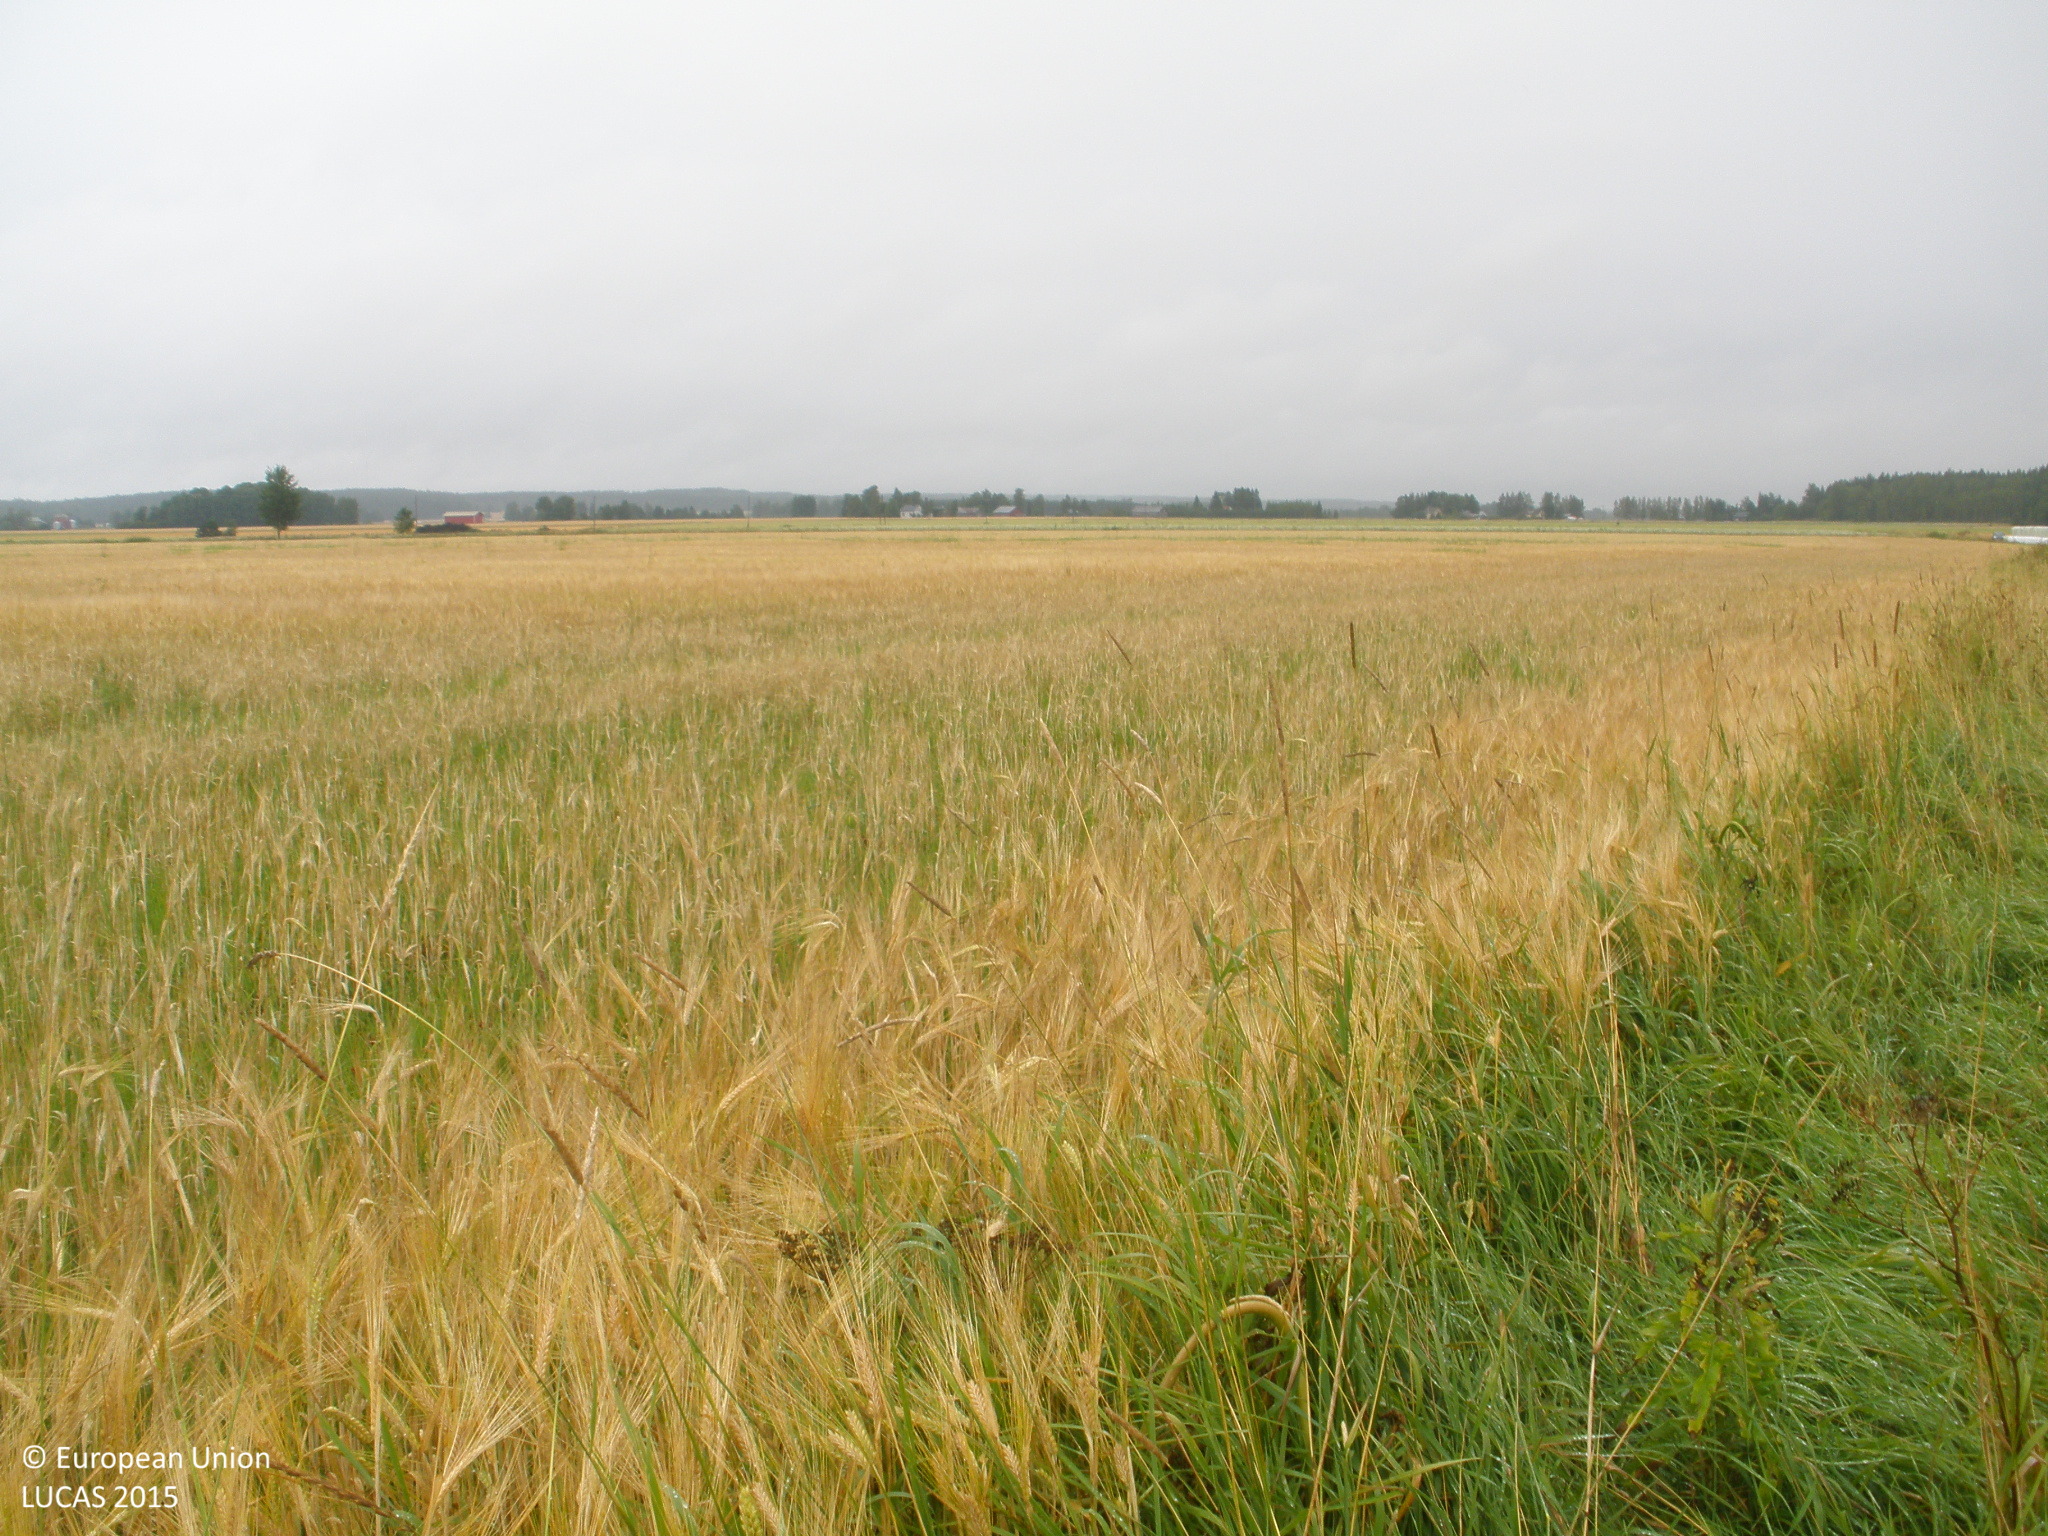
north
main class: Cropland
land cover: Barley
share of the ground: 50 - 75 %
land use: Agriculture (excluding fallow land and kitchen gardens)
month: August
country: FI
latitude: 60.4440
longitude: 23.2961
